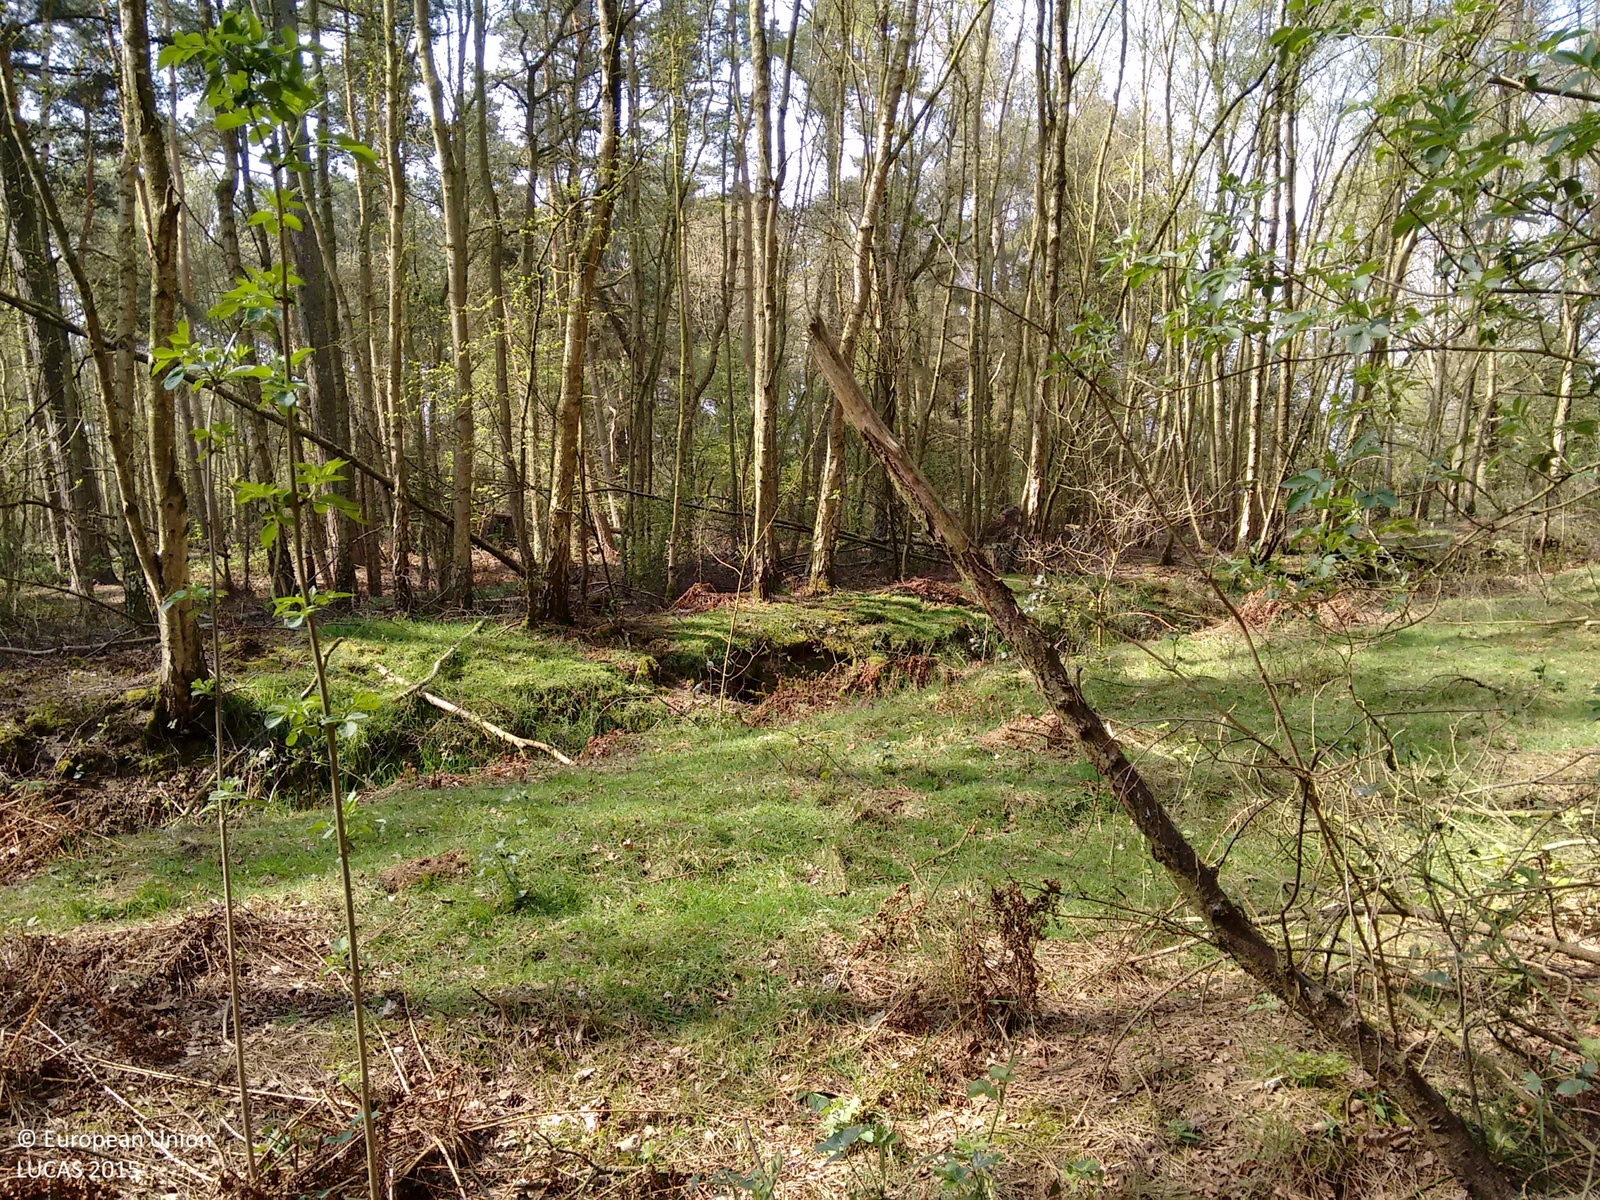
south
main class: Woodland
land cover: Pine dominated coniferous woodland
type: hemiboreal forest and nemoral coniferous forest and mixed broadleaved-coniferous forest
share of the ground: > 75 %
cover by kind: coniferous forest trees 75 %, broadleaved forest trees 25 %
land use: Forestry
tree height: > 5 m
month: April
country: GB
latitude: 53.4662
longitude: -0.7504
